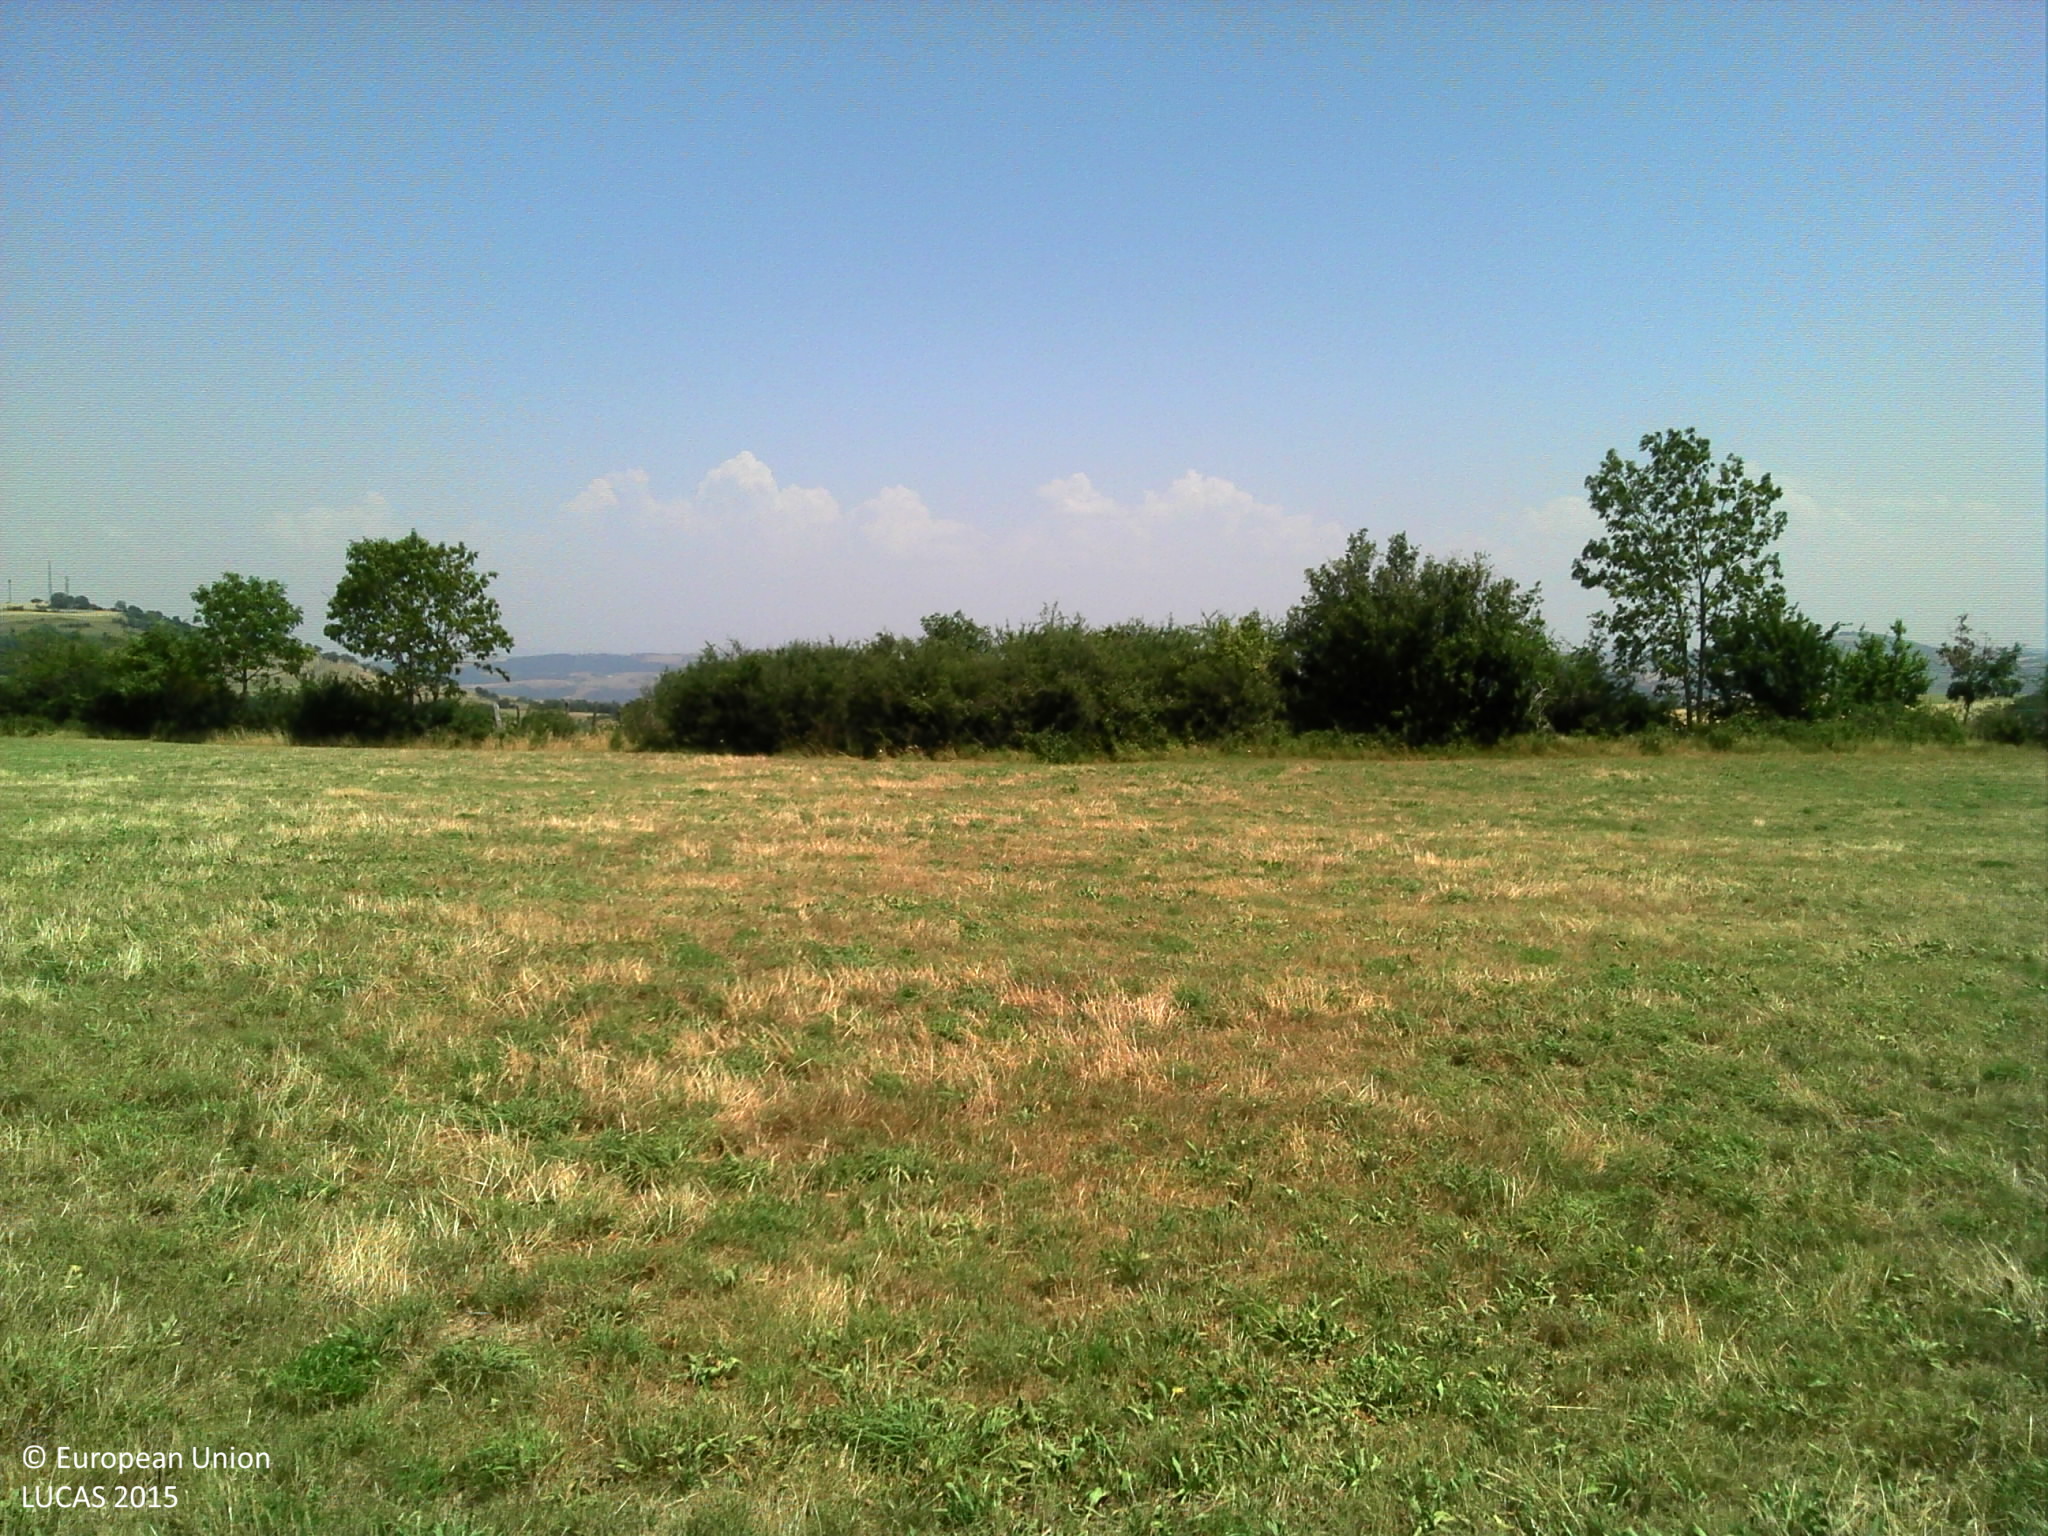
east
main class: Grassland
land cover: Grassland without tree/shrub cover
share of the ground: > 75 %
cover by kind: herbaceous plants 100 %
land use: Agriculture (excluding fallow land and kitchen gardens)
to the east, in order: Grassland without tree/shrub cover; Dry stone walls; Fences; Shrubland with sparse tree cover; Fences; Dry stone walls; Abandoned hedges; Grass margins; Temporary grasslands; Abandoned hedges; Grassland without tree/shrub cover; Abandoned hedges; Fences; Dry stone walls; Abandoned hedges; Grassland without tree/shrub cover; Fences; Grassland without tree/shrub cover; Shrubland with sparse tree cover
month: July
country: FR
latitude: 45.2071
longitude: 3.1138
